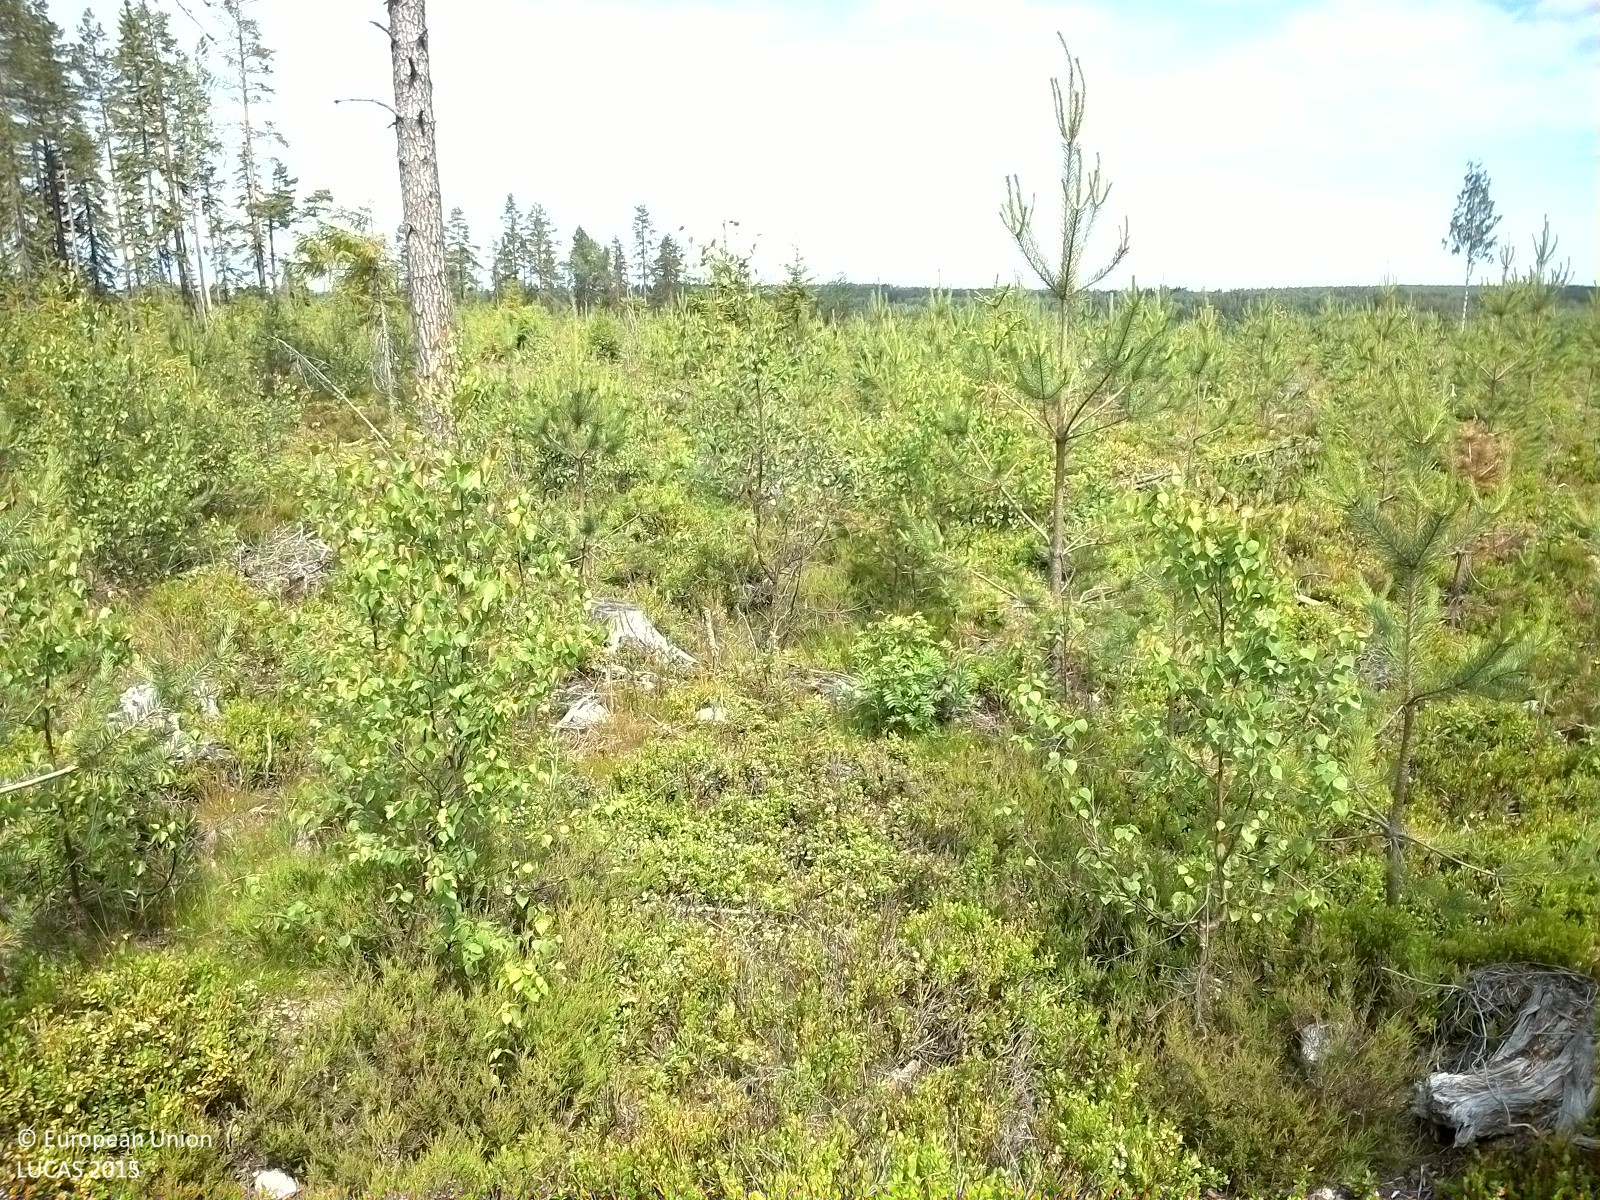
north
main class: Woodland
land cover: Pine dominated mixed woodland
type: boreal forest
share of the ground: 25 - 50 %
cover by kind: shrubs 65 %, coniferous forest trees 25 %, broadleaved forest trees 10 %
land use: Forestry
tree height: < 5 m
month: July
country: SE
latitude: 62.1335
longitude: 17.1733
